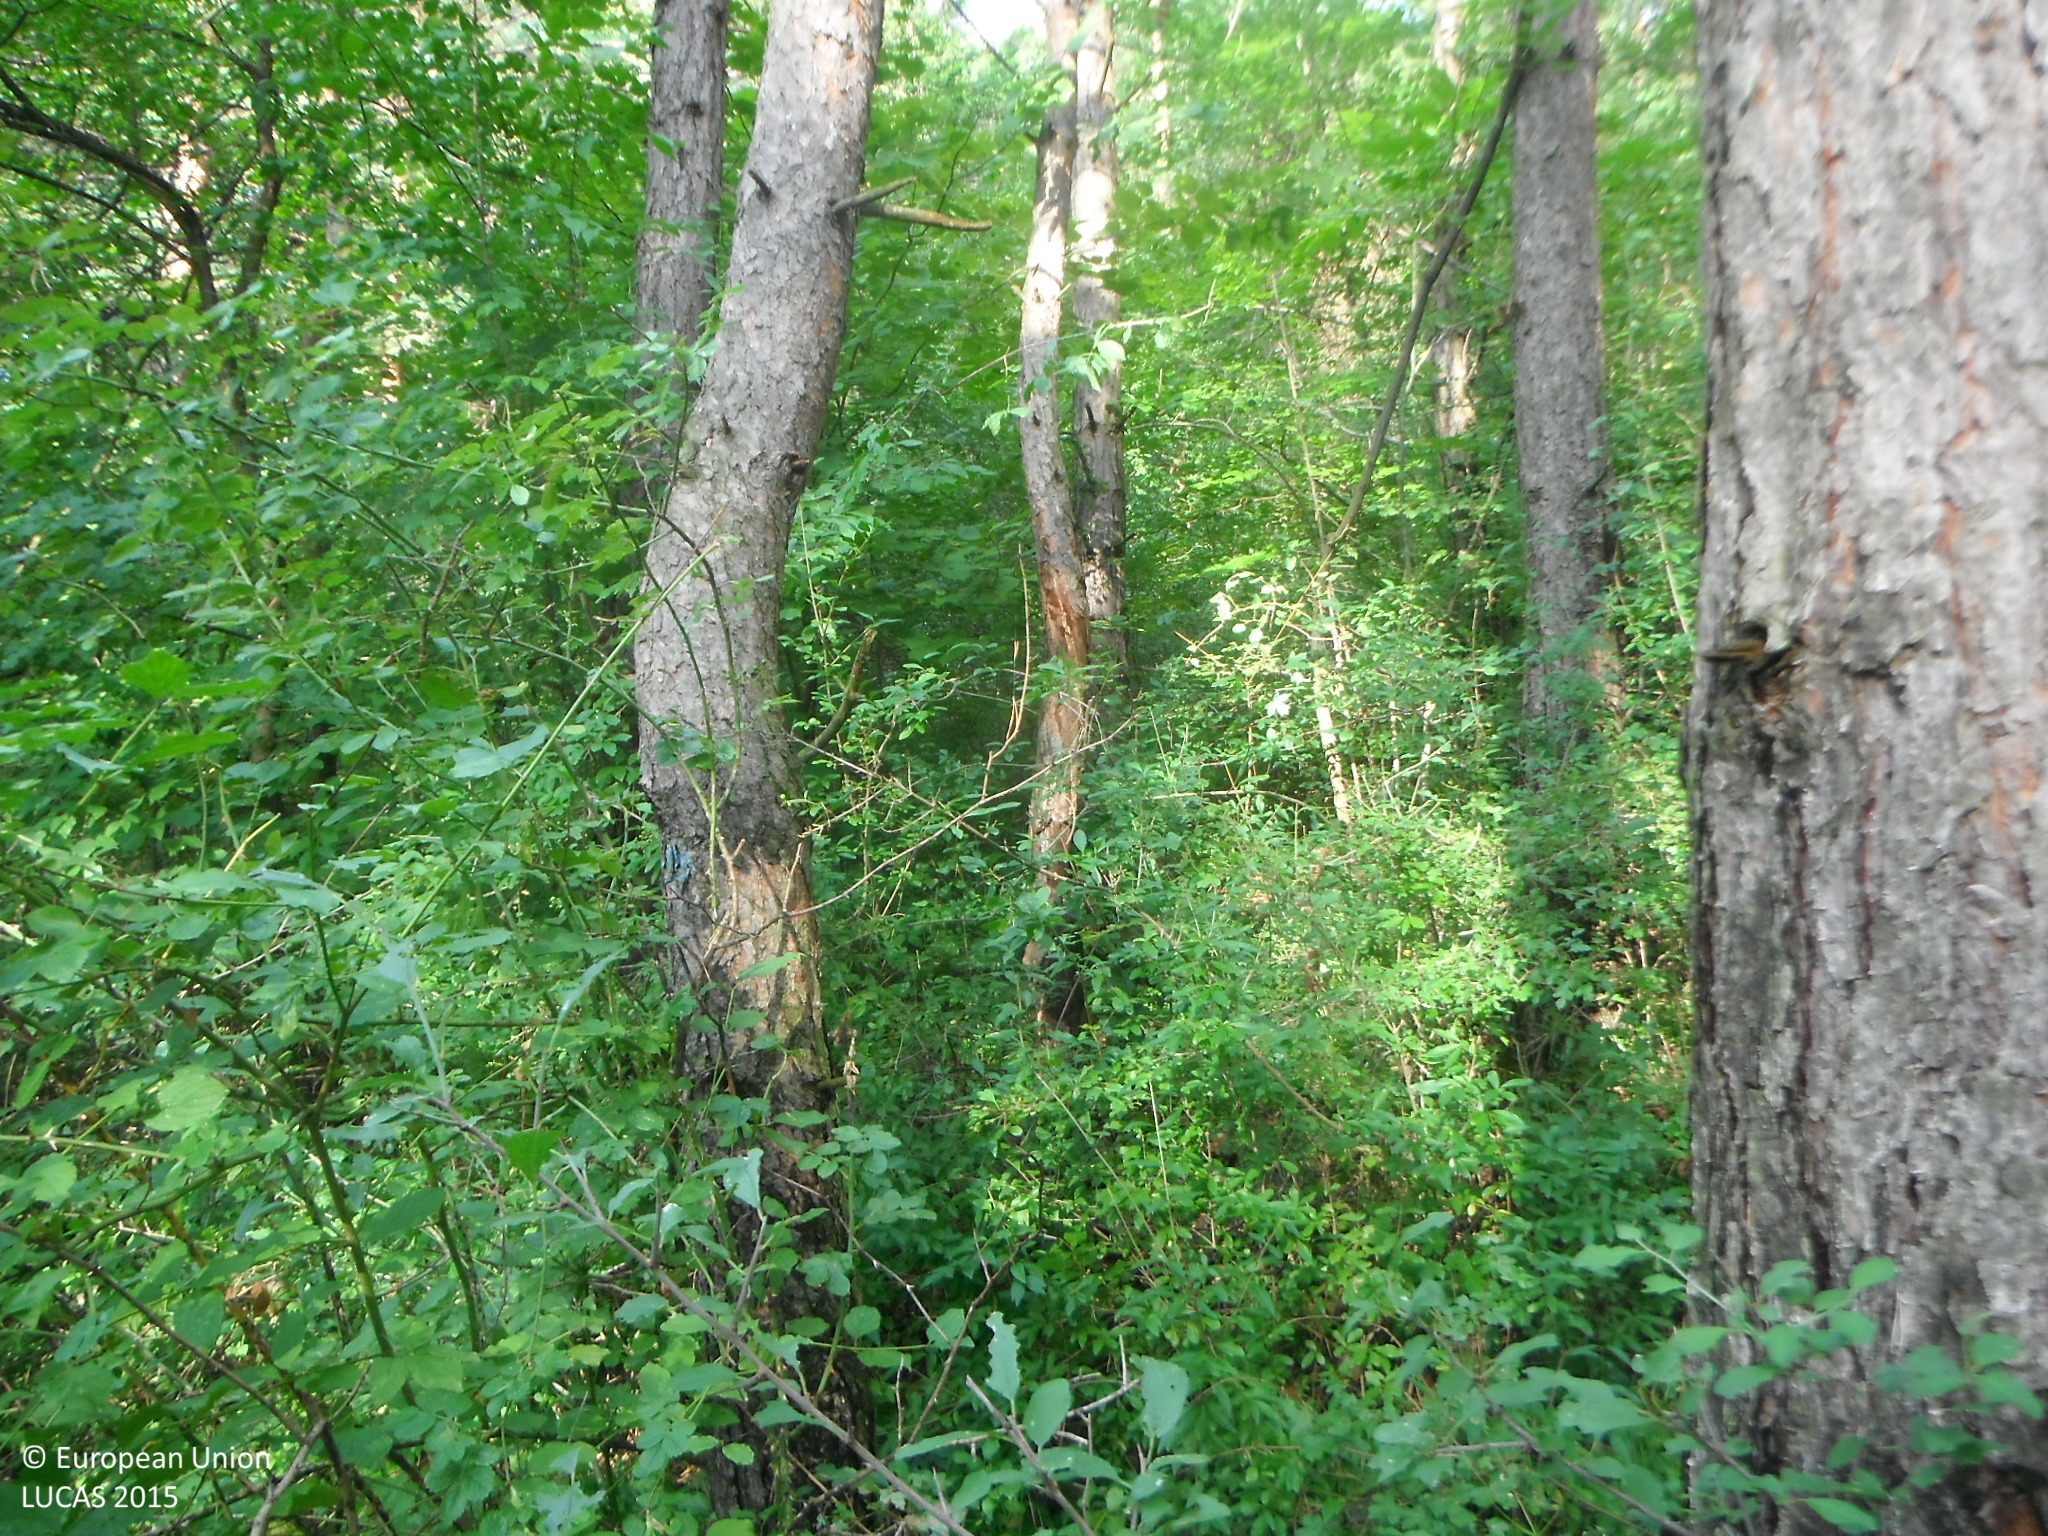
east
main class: Woodland
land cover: Pine dominated coniferous woodland
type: hemiboreal forest and nemoral coniferous forest and mixed broadleaved-coniferous forest
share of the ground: > 75 %
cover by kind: coniferous forest trees 90 %, broadleaved forest trees 10 %
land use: Forestry
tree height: > 5 m
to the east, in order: Pine dominated coniferous woodland; Broadleaved woodland; Pine dominated mixed woodland; Broadleaved woodland
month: August
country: SK
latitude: 48.8276
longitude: 18.3667
